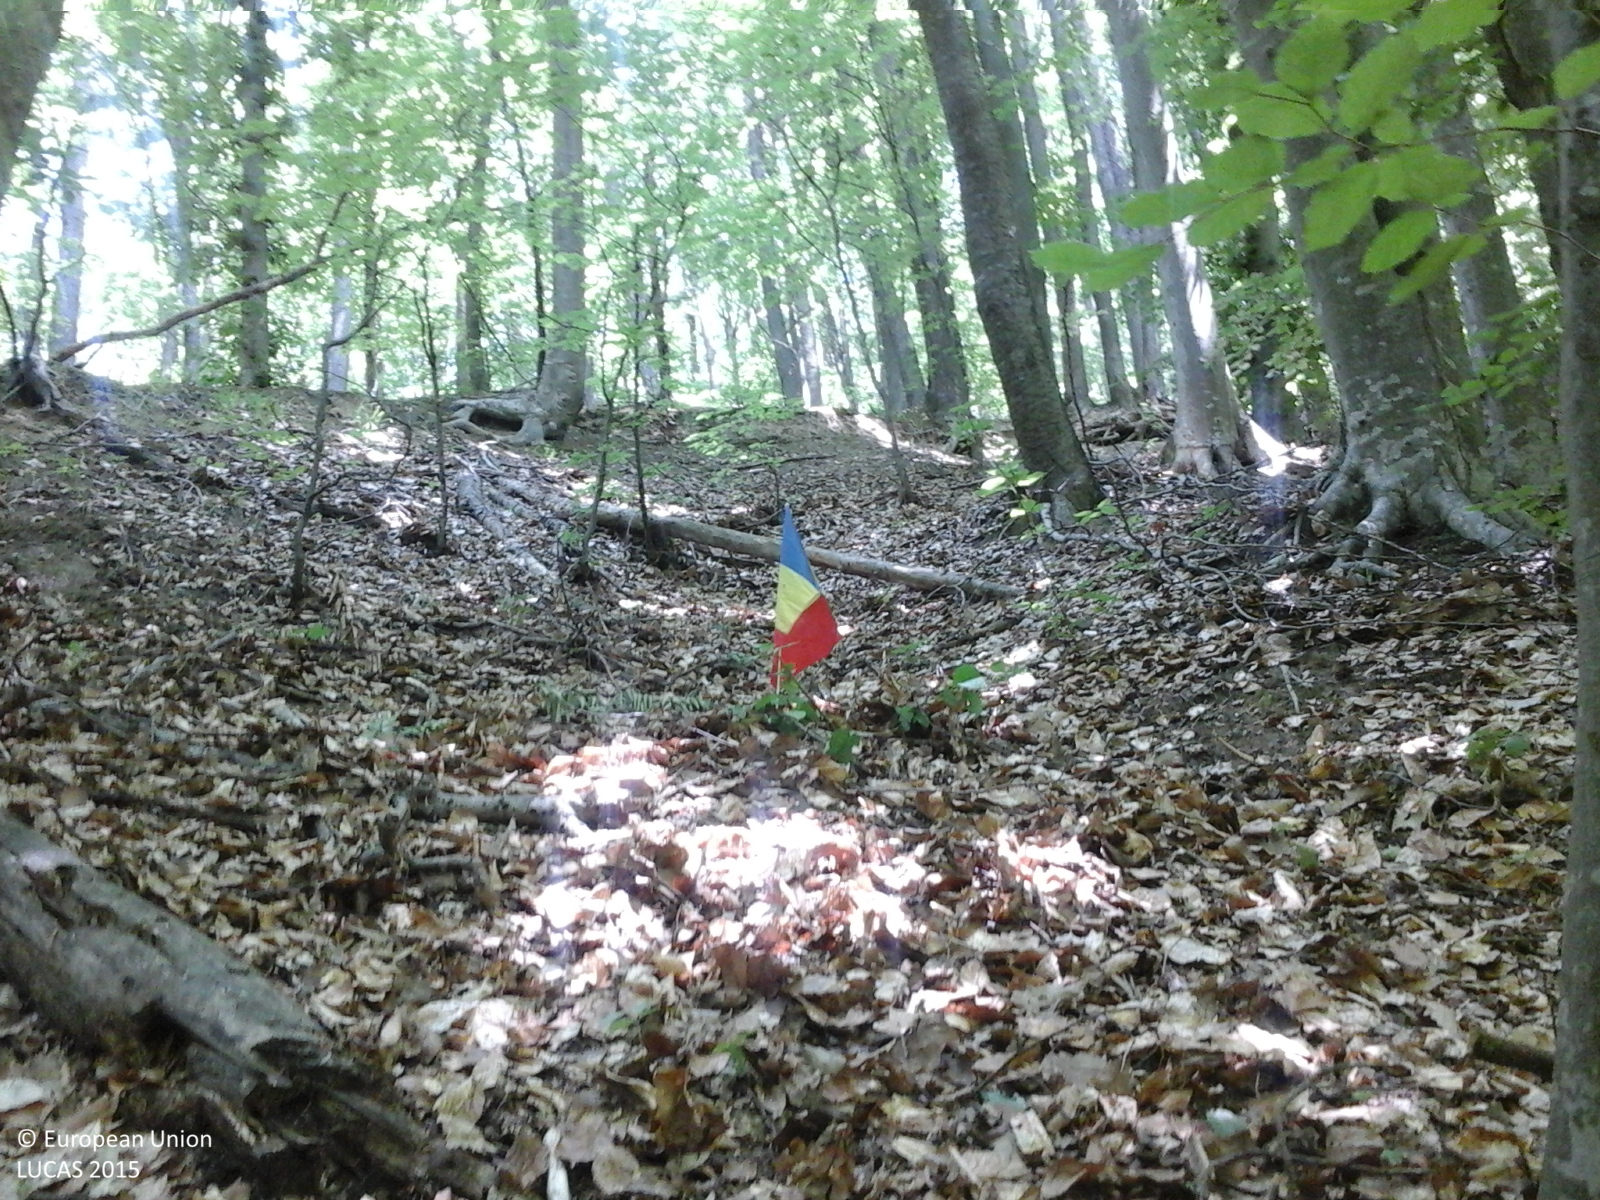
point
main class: Woodland
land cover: Broadleaved woodland
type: beech forest
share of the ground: > 75 %
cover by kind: broadleaved forest trees 100 %
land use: Forestry
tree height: > 5 m
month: June
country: RO
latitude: 46.6015
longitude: 26.7337
